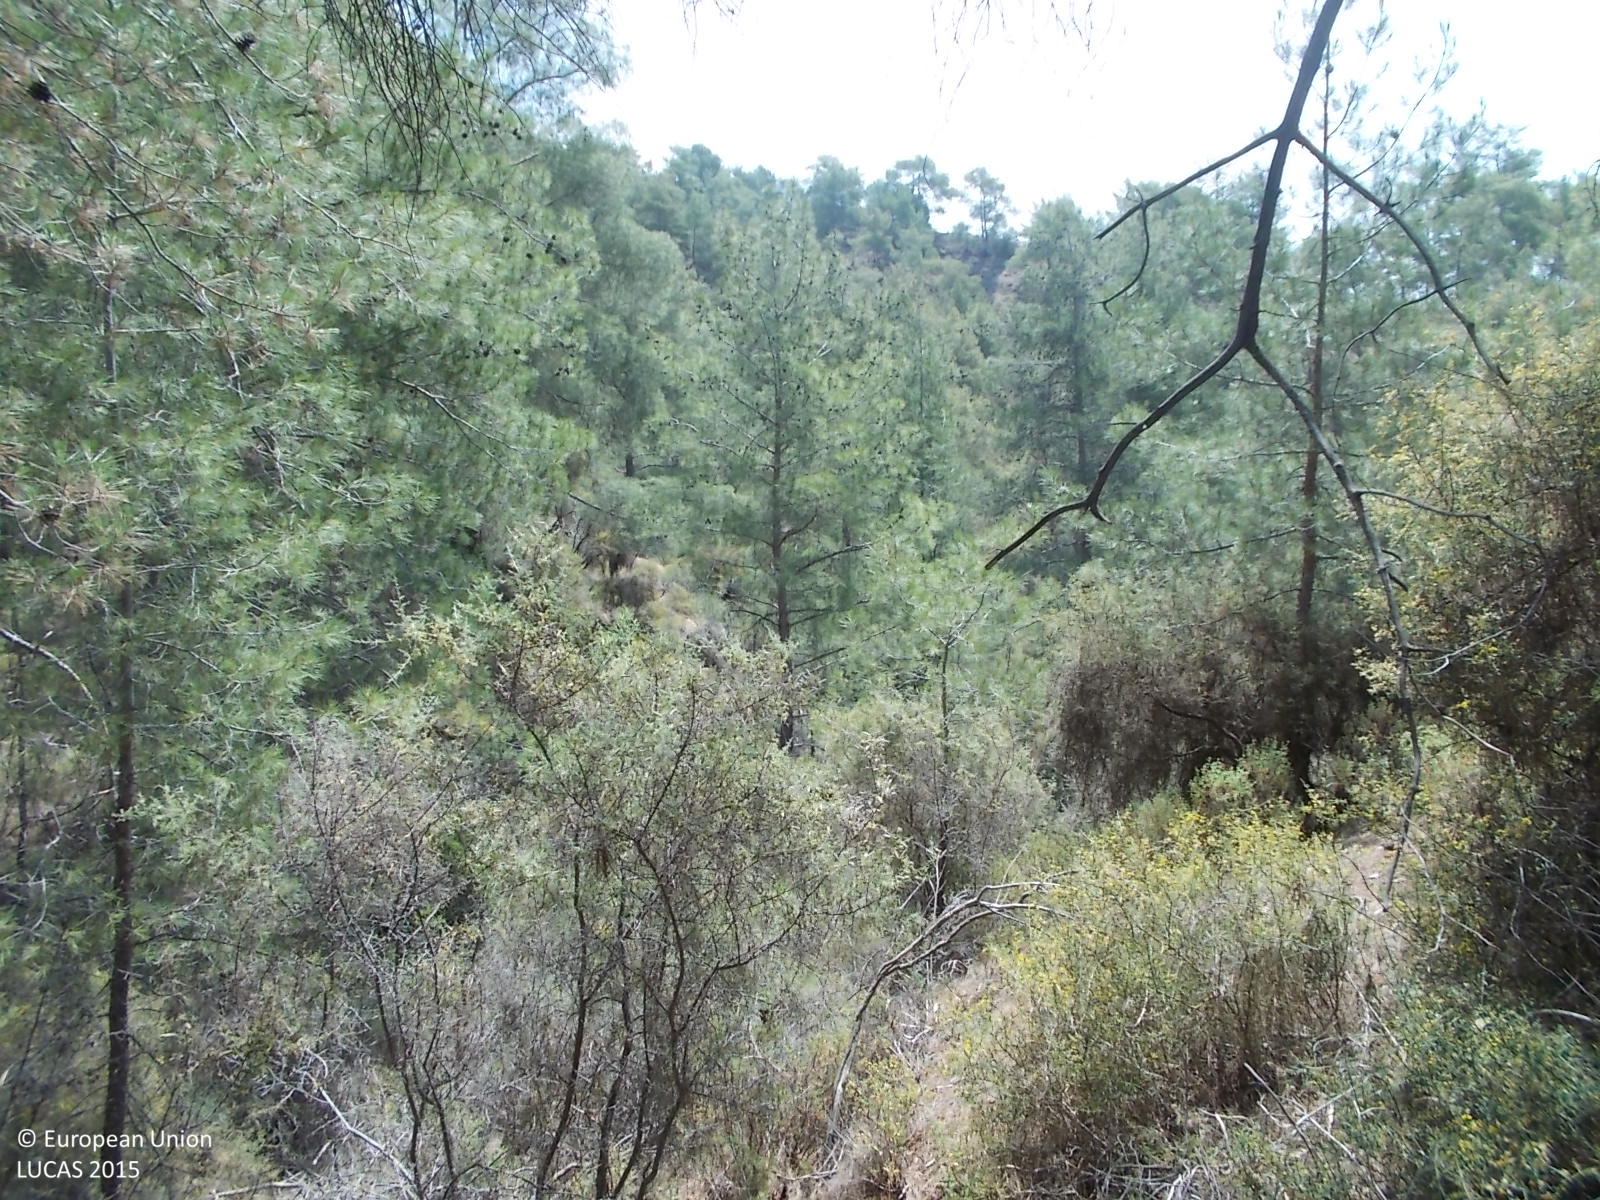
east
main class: Woodland
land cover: Pine dominated coniferous woodland
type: coniferous forest of the mediterranean region
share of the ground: > 75 %
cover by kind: coniferous forest trees 85 %, shrubs 10 %, unconsolidated bare surface 5 %
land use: Forestry
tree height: > 5 m
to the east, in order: Pine dominated coniferous woodland; Paved roads, cycling and walking lanes; Pine dominated coniferous woodland
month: June
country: CY
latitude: 34.8878
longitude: 32.7784
